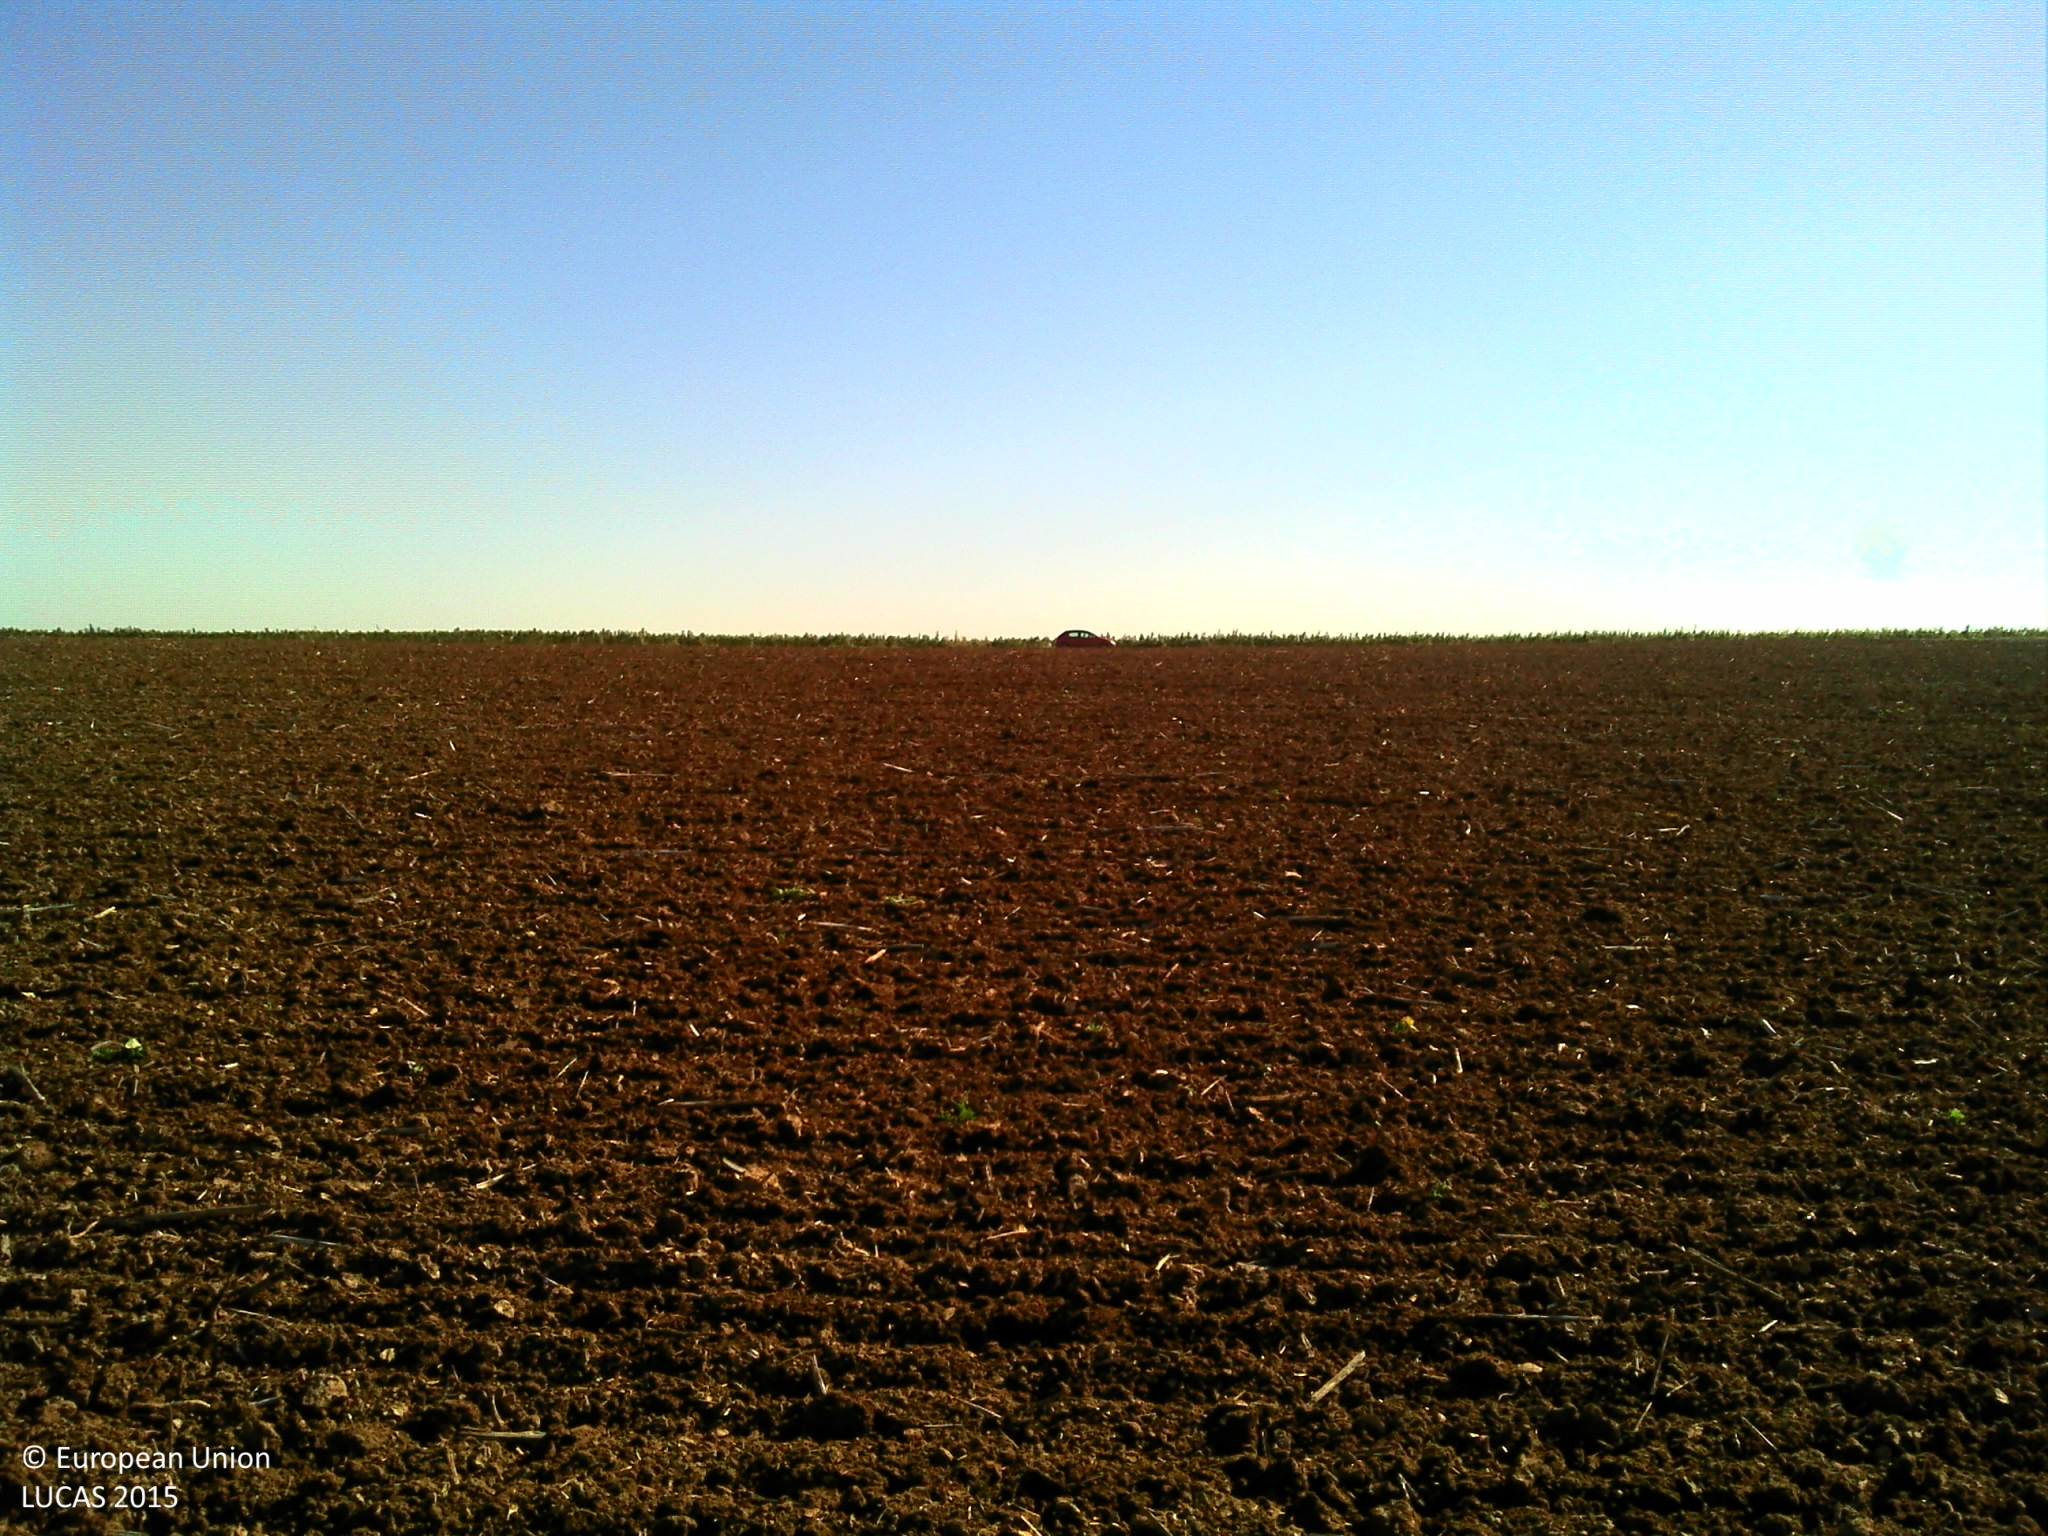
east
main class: Cropland
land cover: Rape and turnip rape
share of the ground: < 10 %
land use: Agriculture (excluding fallow land and kitchen gardens)
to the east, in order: Rape and turnip rape; Tracks; Sunflower; Common wheat
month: September
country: FR
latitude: 48.4025
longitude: 3.3613
